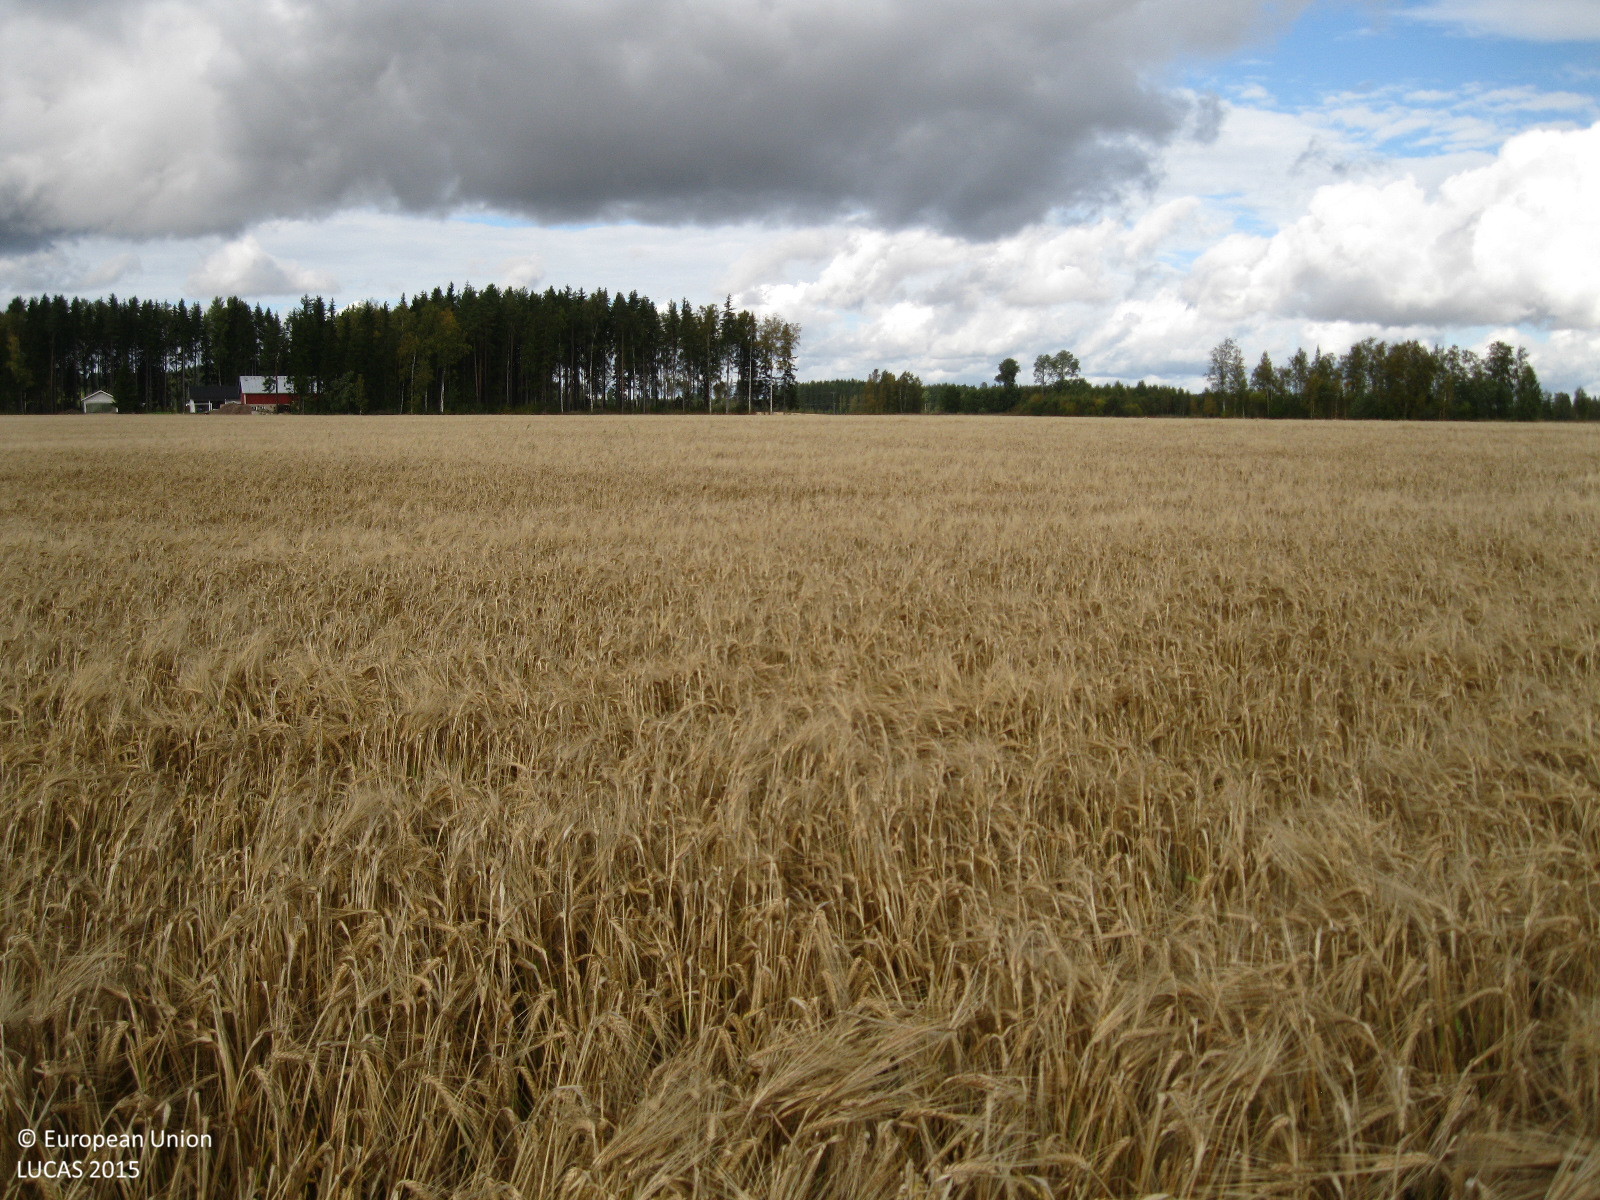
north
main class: Cropland
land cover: Barley
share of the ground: > 75 %
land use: Agriculture (excluding fallow land and kitchen gardens)
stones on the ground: < 10 %
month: September
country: FI
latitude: 60.7772
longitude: 24.7444
